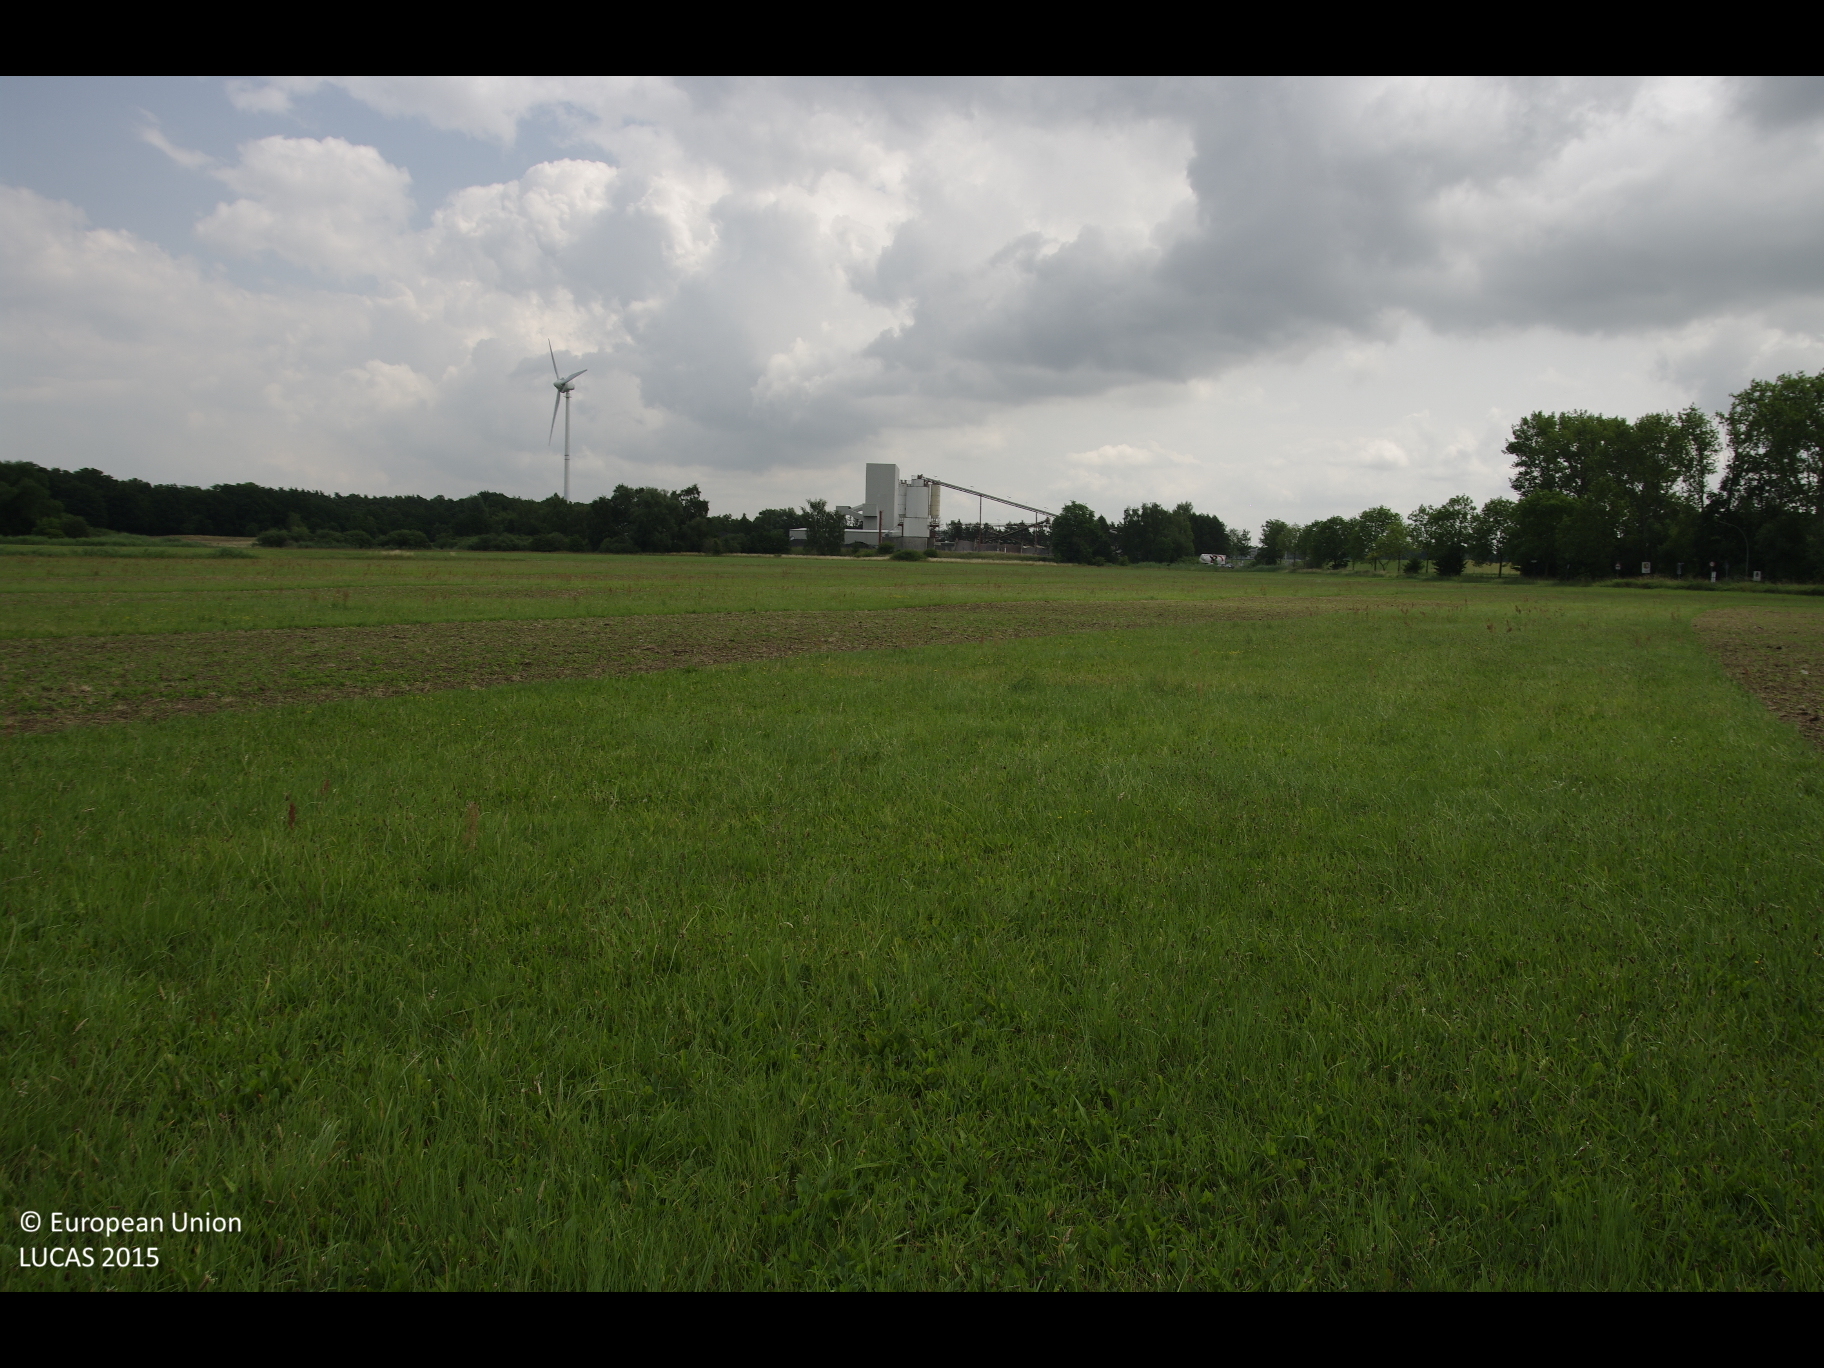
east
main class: Grassland
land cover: Grassland without tree/shrub cover
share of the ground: > 75 %
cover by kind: herbaceous plants 100 %
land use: Agriculture (excluding fallow land and kitchen gardens)
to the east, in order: Grassland without tree/shrub cover
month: July
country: DE
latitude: 53.4374
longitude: 10.3160
